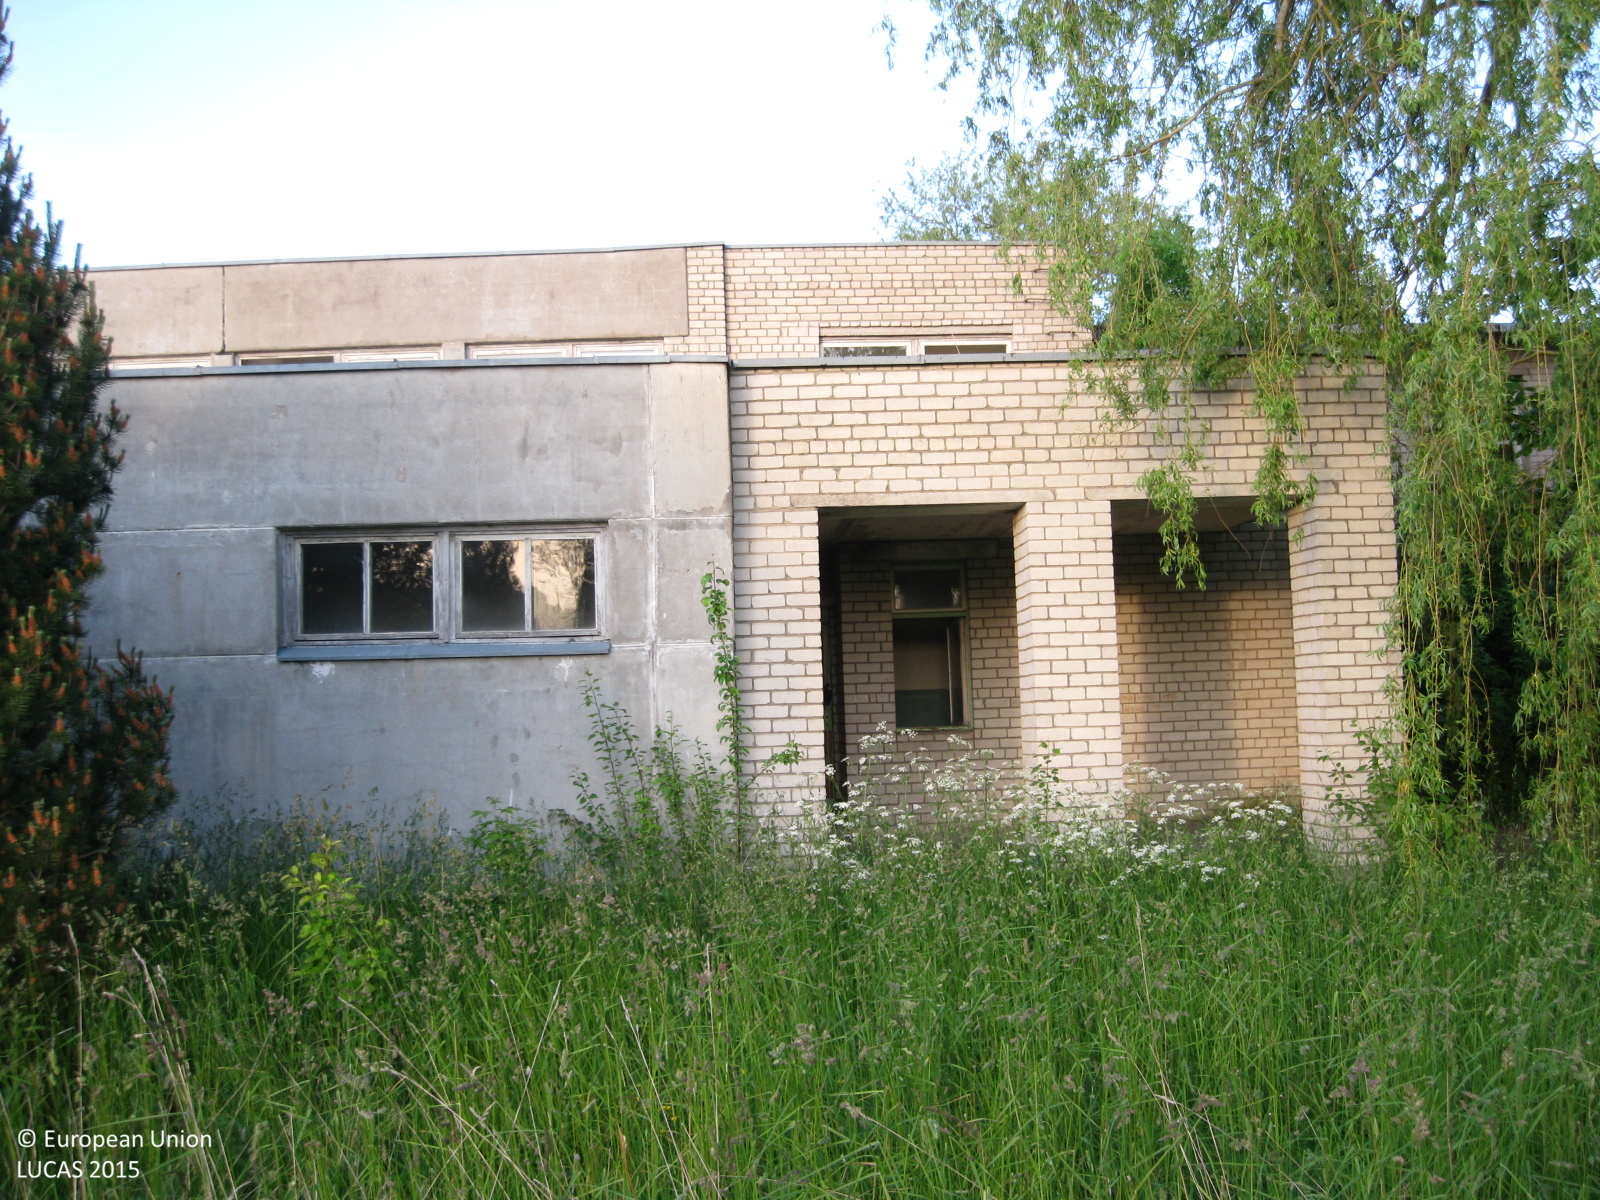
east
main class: Grassland
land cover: Grassland with sparse tree/shrub cover
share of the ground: > 75 %
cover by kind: herbaceous plants 90 %, coniferous forest trees 5 %, shrubs 5 %
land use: Abandoned areas
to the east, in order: Grassland with sparse tree/shrub cover; Artificial constructions in urban areas; Apple fruit; Electric lines; Broadleaved woodland; Grassland without tree/shrub cover; Paved roads, cycling and walking lanes; Grassland without tree/shrub cover; Common wheat; Spontaneously vegetated surfaces; Ditches and canals; Spontaneously vegetated surfaces; Common wheat
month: June
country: LT
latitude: 55.4521
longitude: 23.6645
